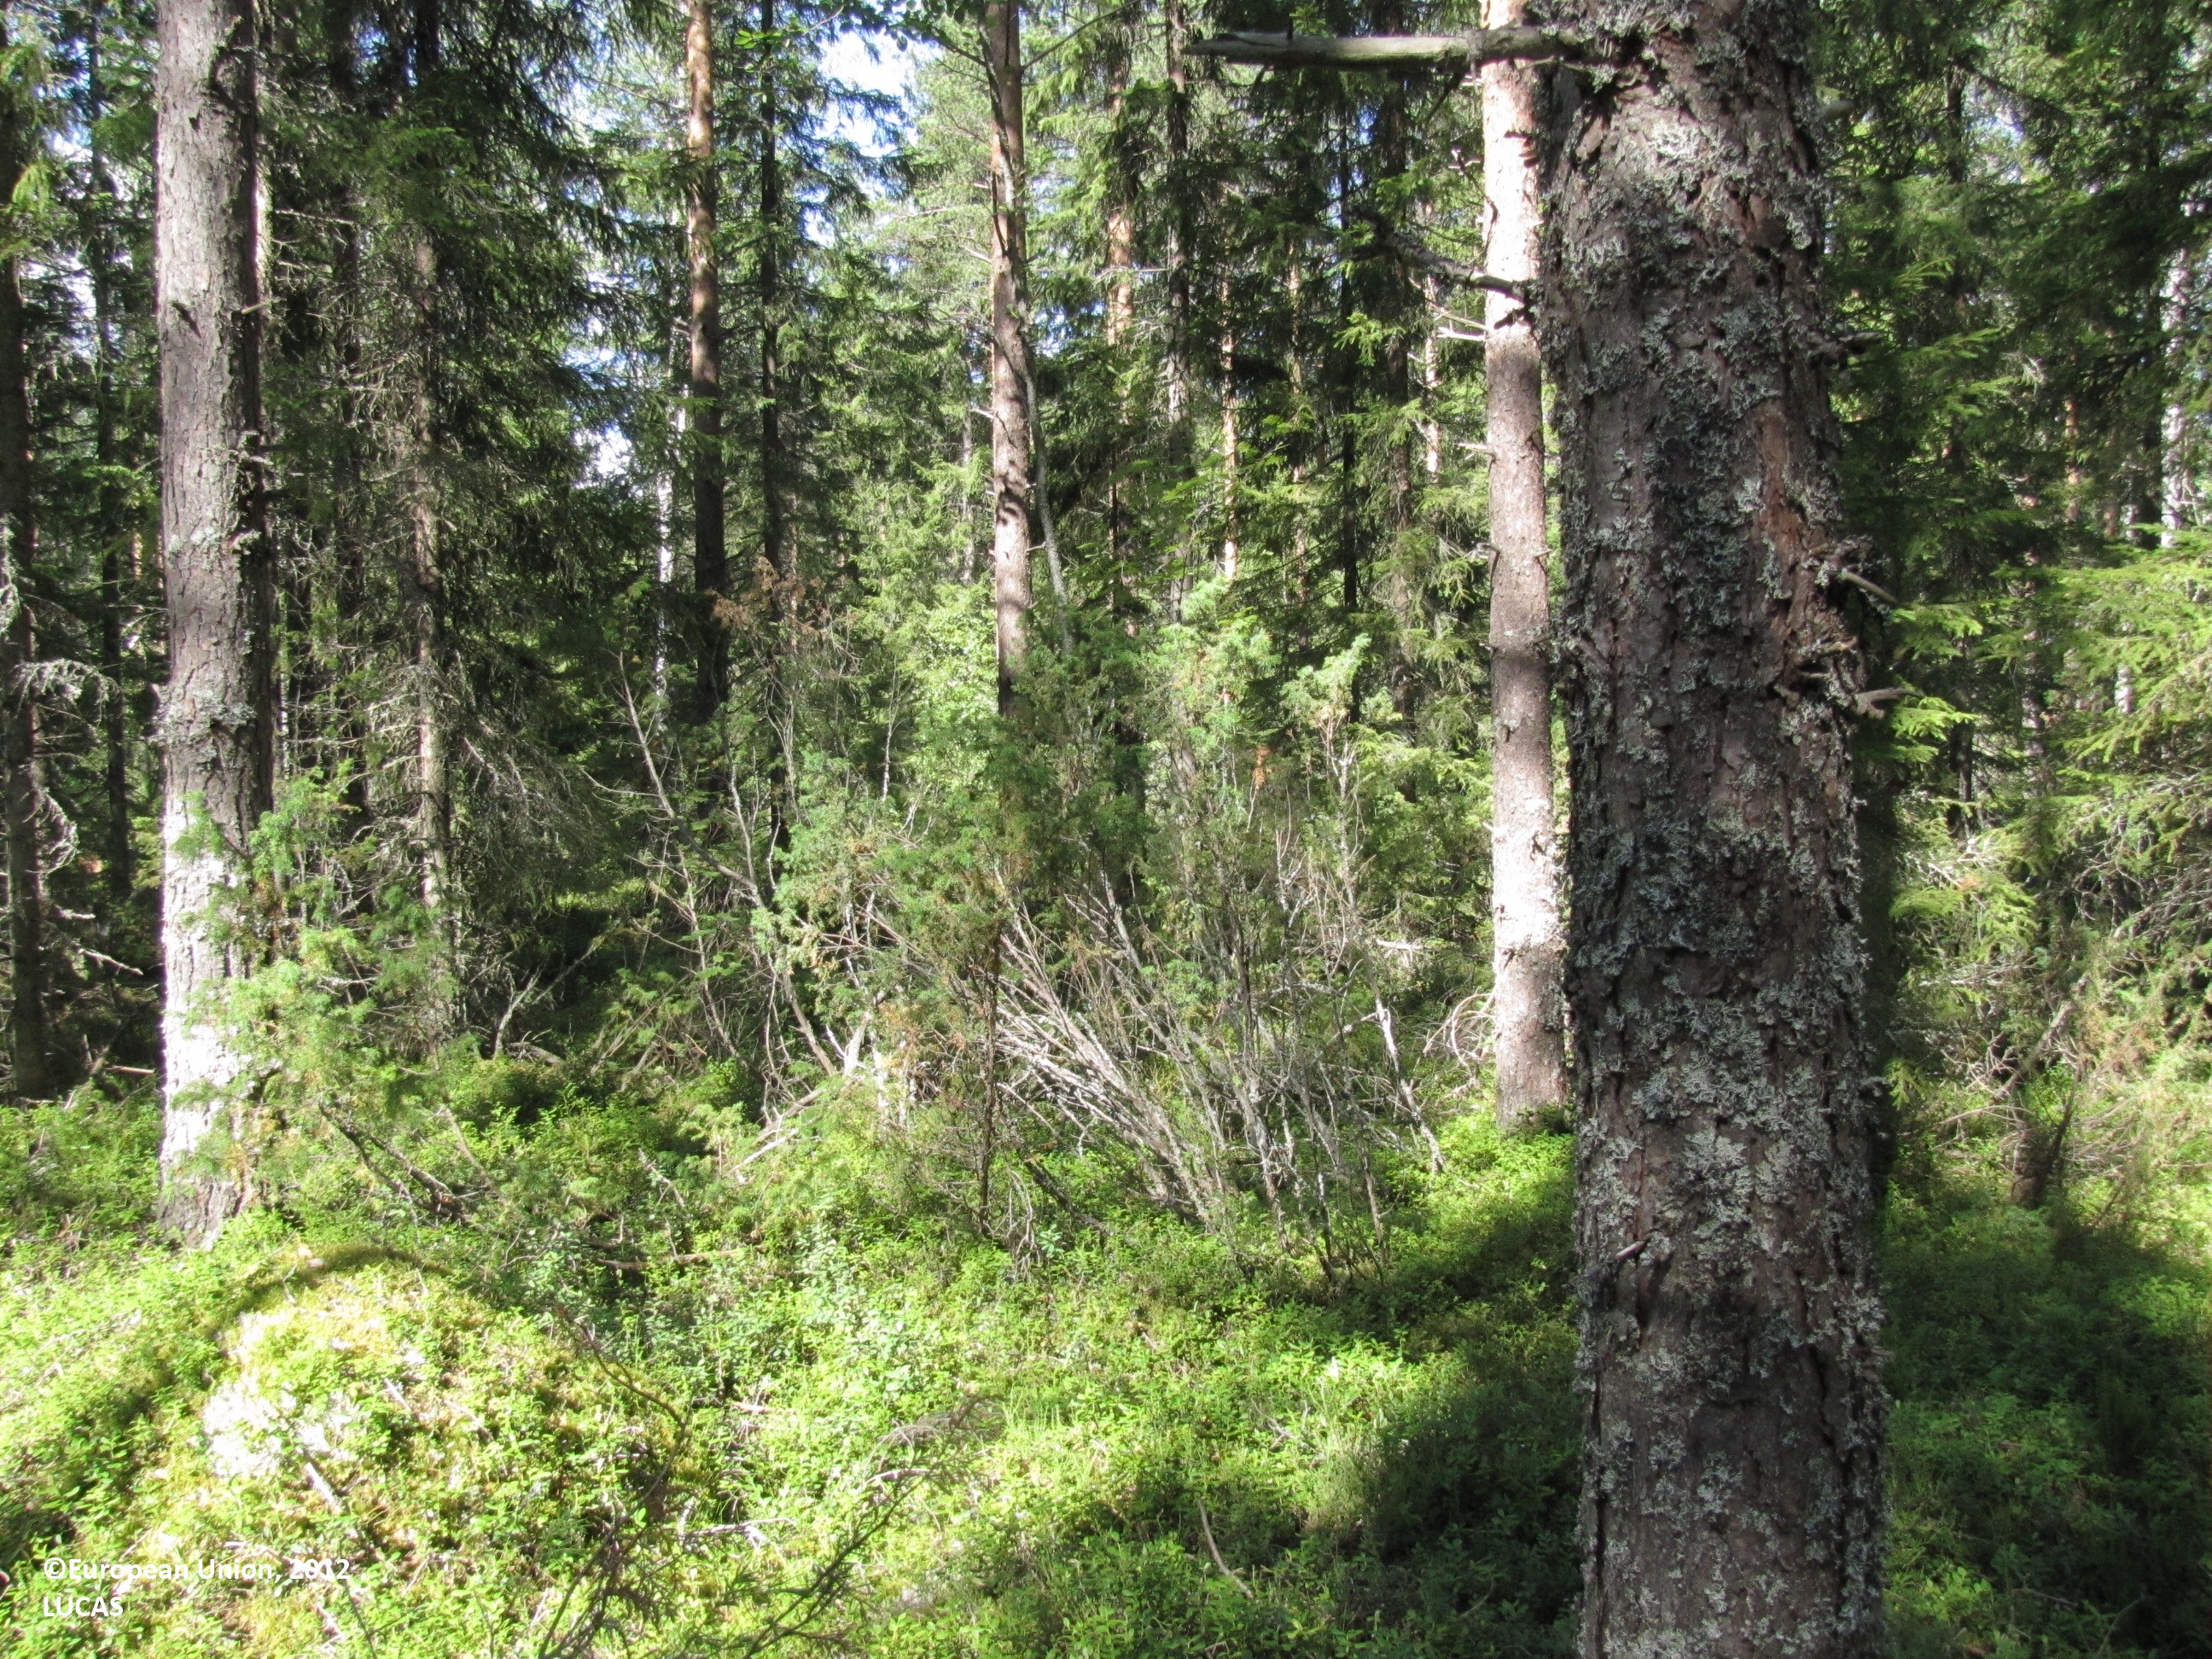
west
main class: Woodland
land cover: Other coniferous woodland
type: boreal forest
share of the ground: > 75 %
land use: Forestry
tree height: > 5 m
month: July
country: FI
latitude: 62.1163
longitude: 23.2376
